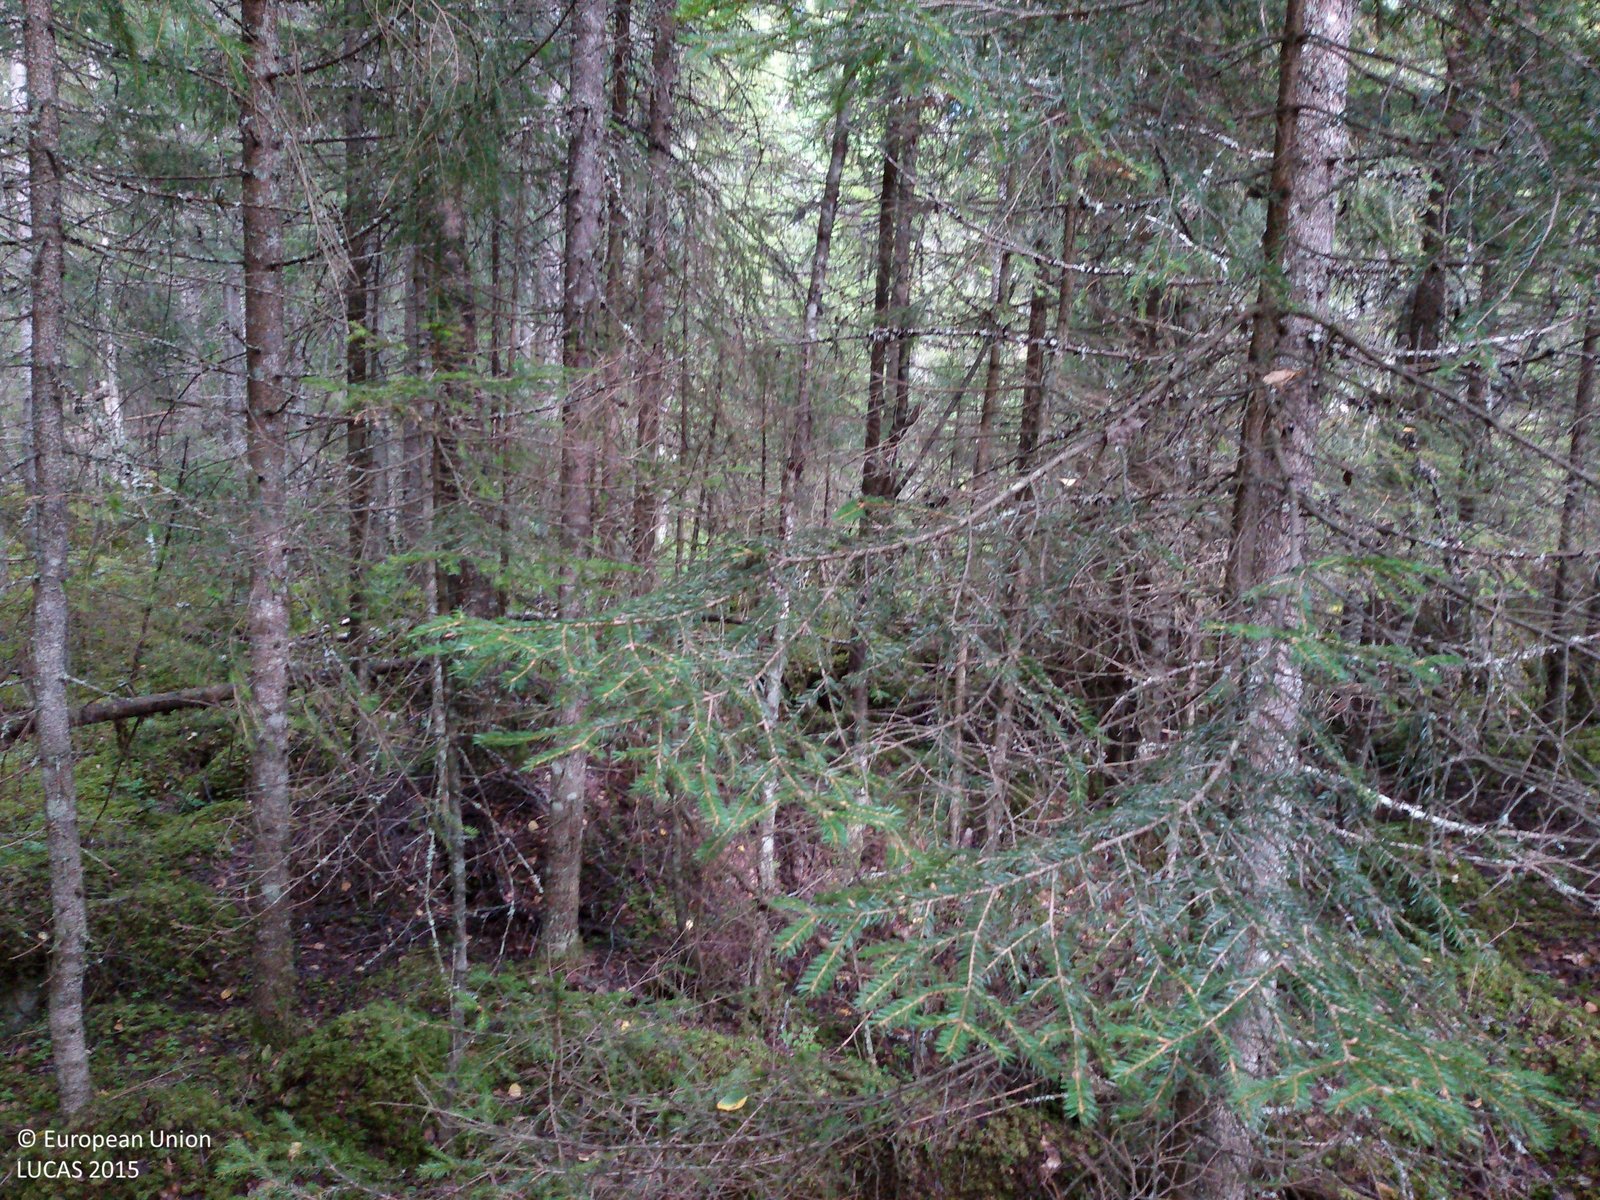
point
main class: Woodland
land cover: Spruce dominated coniferous woodland
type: boreal forest
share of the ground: > 75 %
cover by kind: coniferous forest trees 90 %, lichens and mosses 10 %
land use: Forestry
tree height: > 5 m
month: September
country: SE
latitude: 60.9454
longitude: 15.3577
